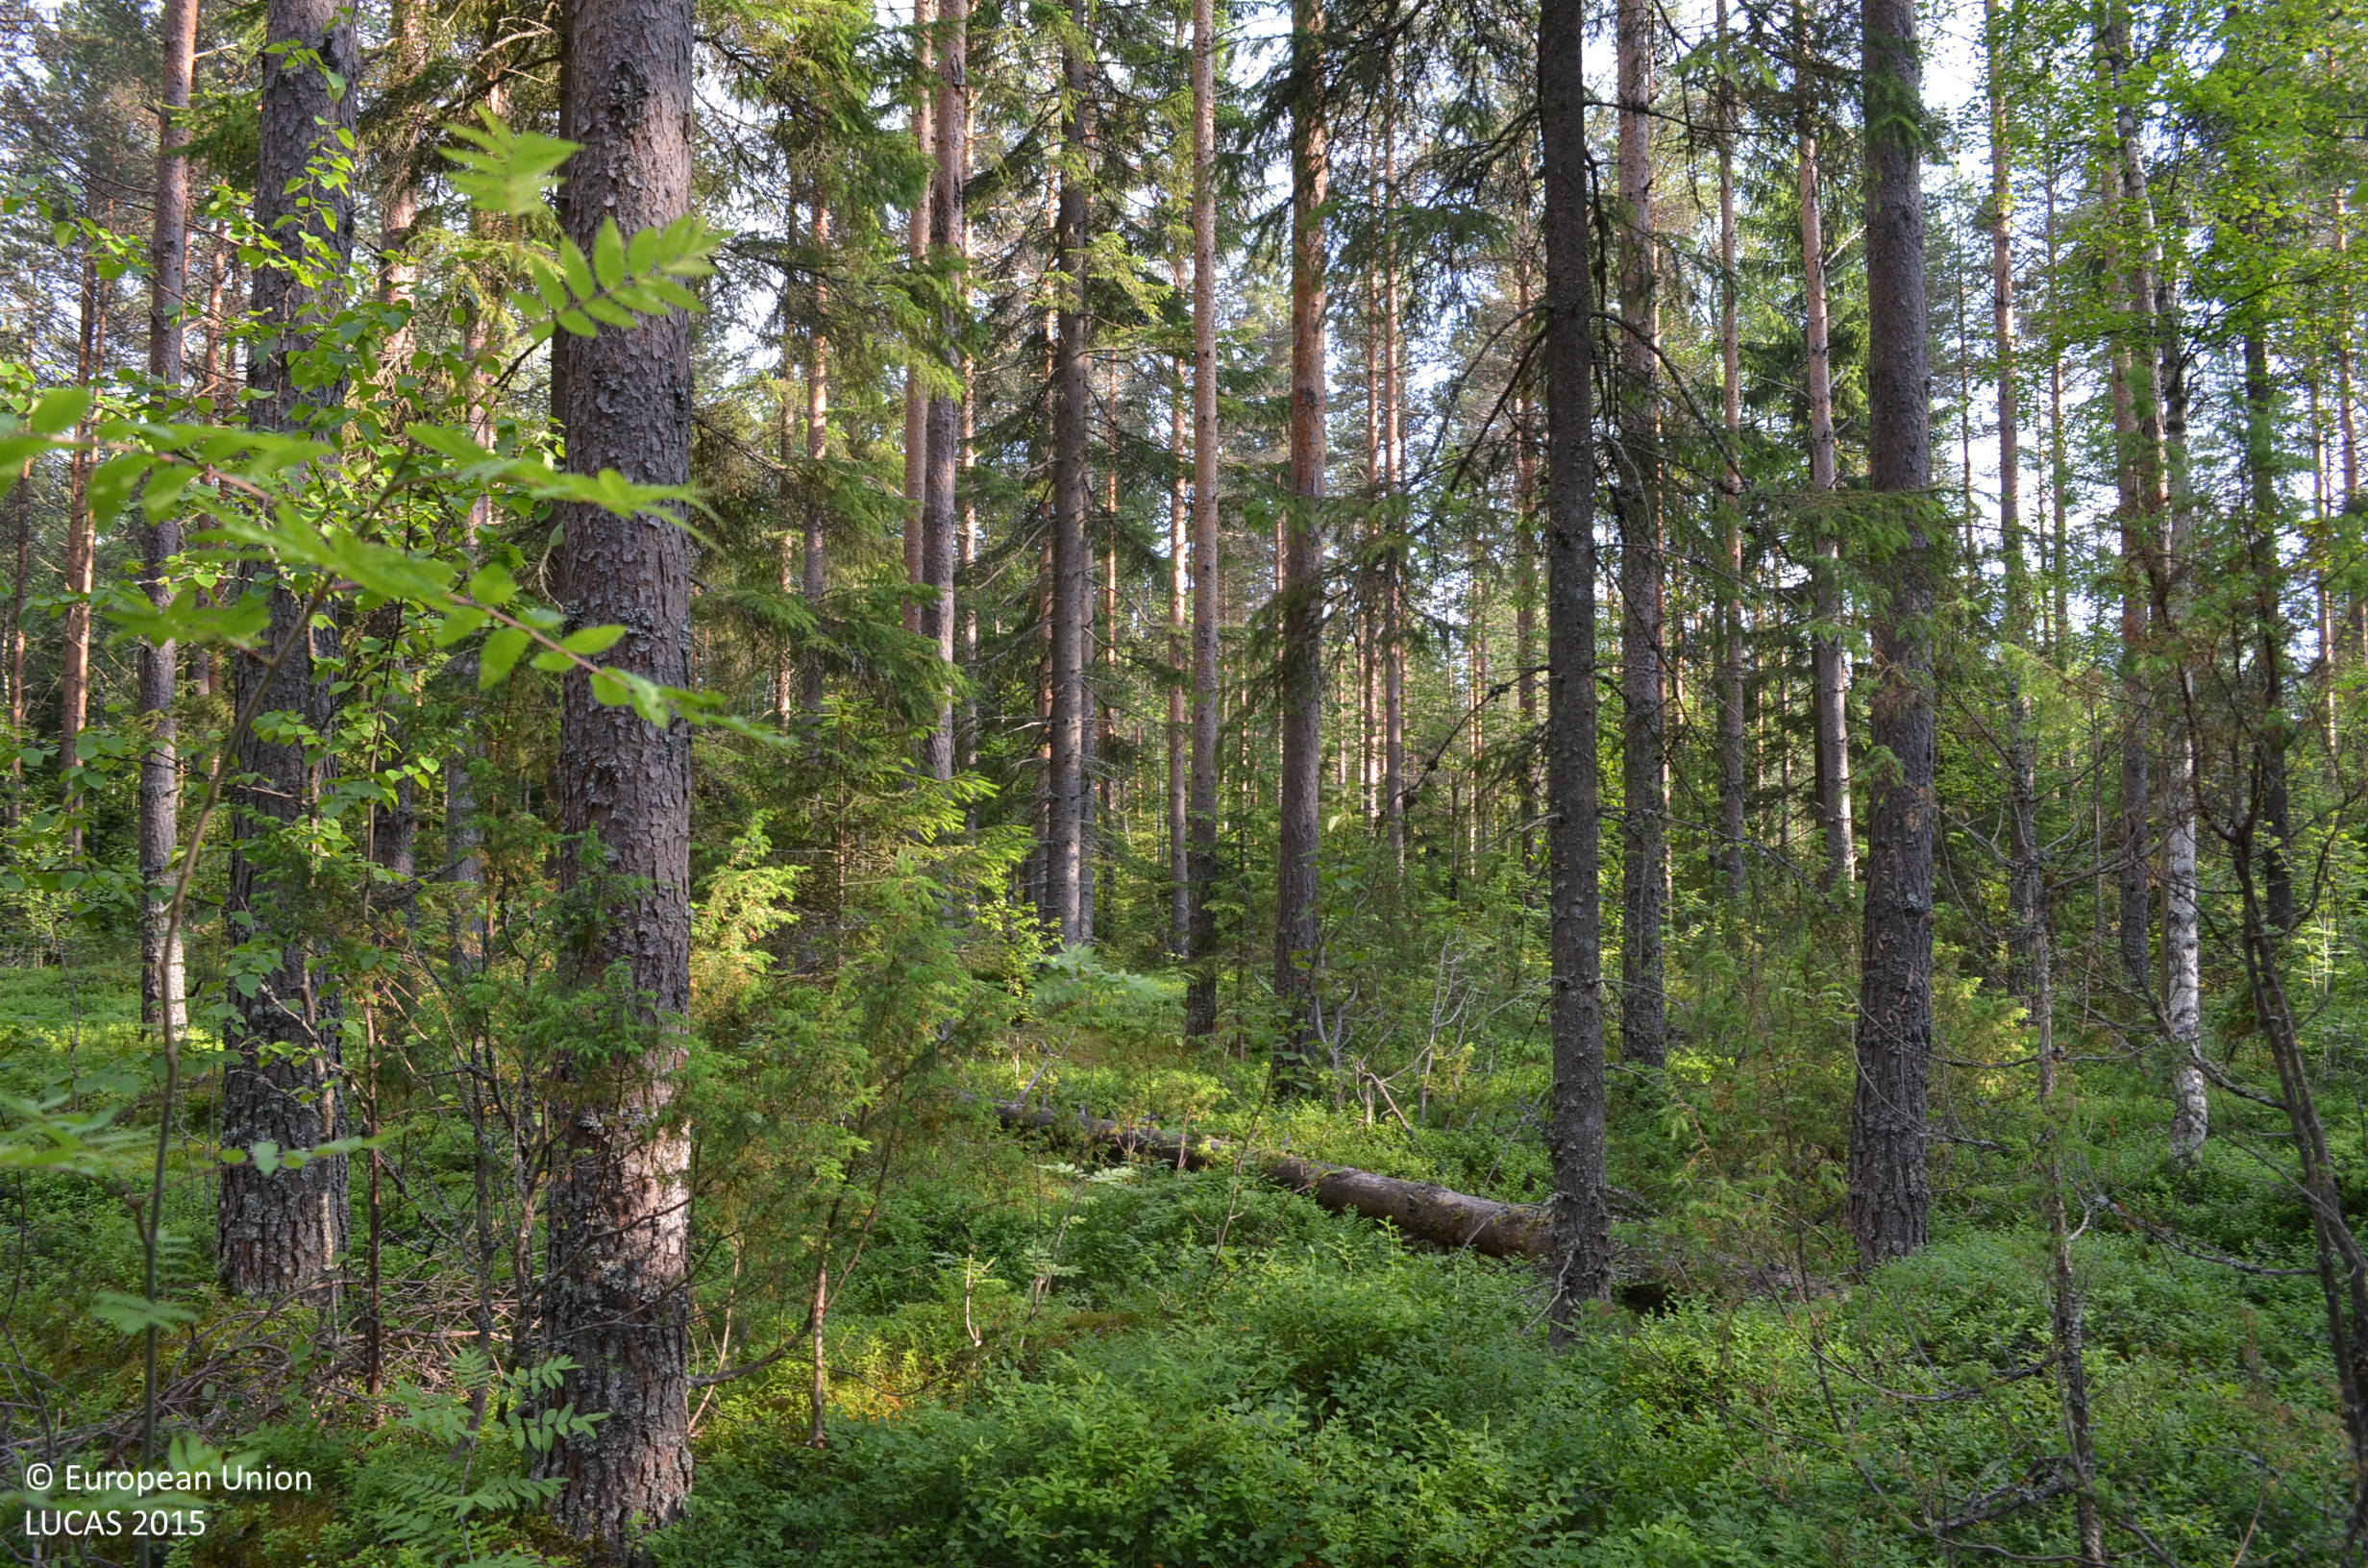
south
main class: Woodland
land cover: Pine dominated coniferous woodland
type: boreal forest
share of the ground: > 75 %
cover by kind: coniferous forest trees 70 %, shrubs 25 %, broadleaved forest trees 5 %
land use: Forestry
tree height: > 5 m
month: July
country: FI
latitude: 62.2825
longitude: 23.4275
